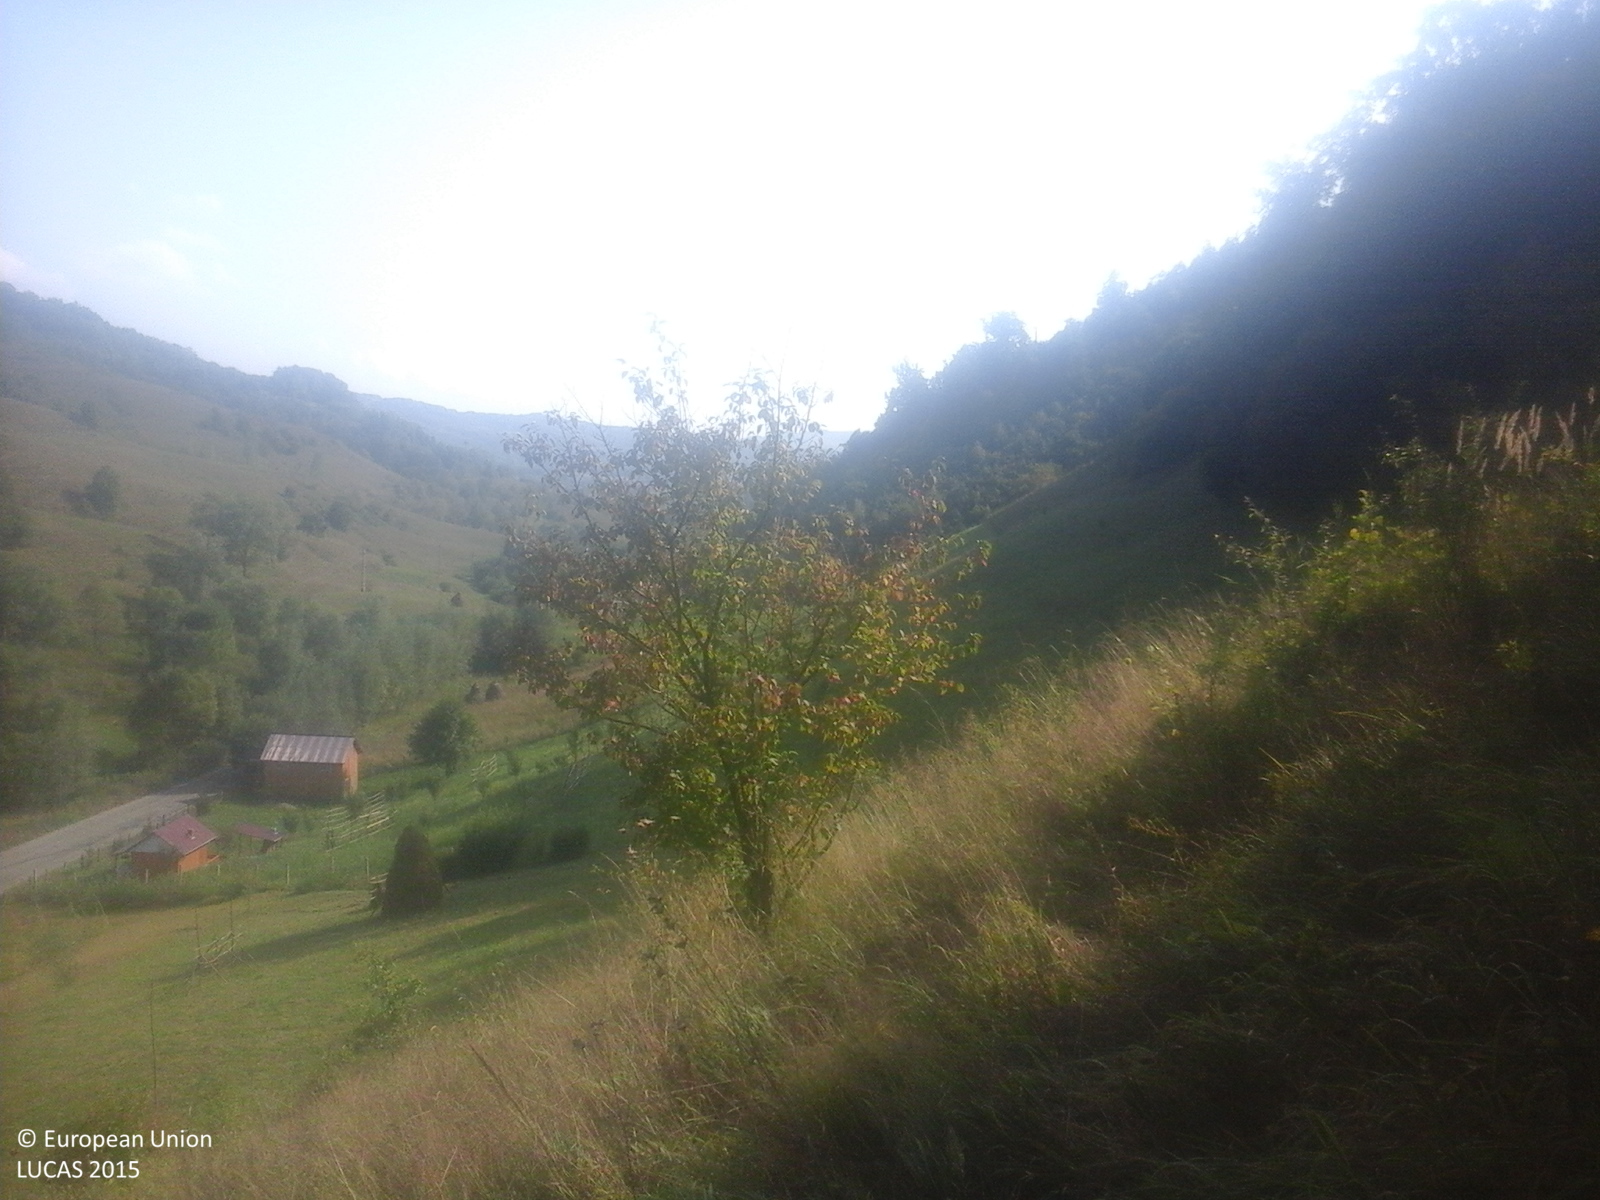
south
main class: Grassland
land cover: Grassland with sparse tree/shrub cover
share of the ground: > 75 %
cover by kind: herbaceous plants 85 %, shrubs 10 %, broadleaved forest trees 5 %
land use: Agriculture (excluding fallow land and kitchen gardens)
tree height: < 5 m
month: September
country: RO
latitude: 47.7217
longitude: 24.3154
